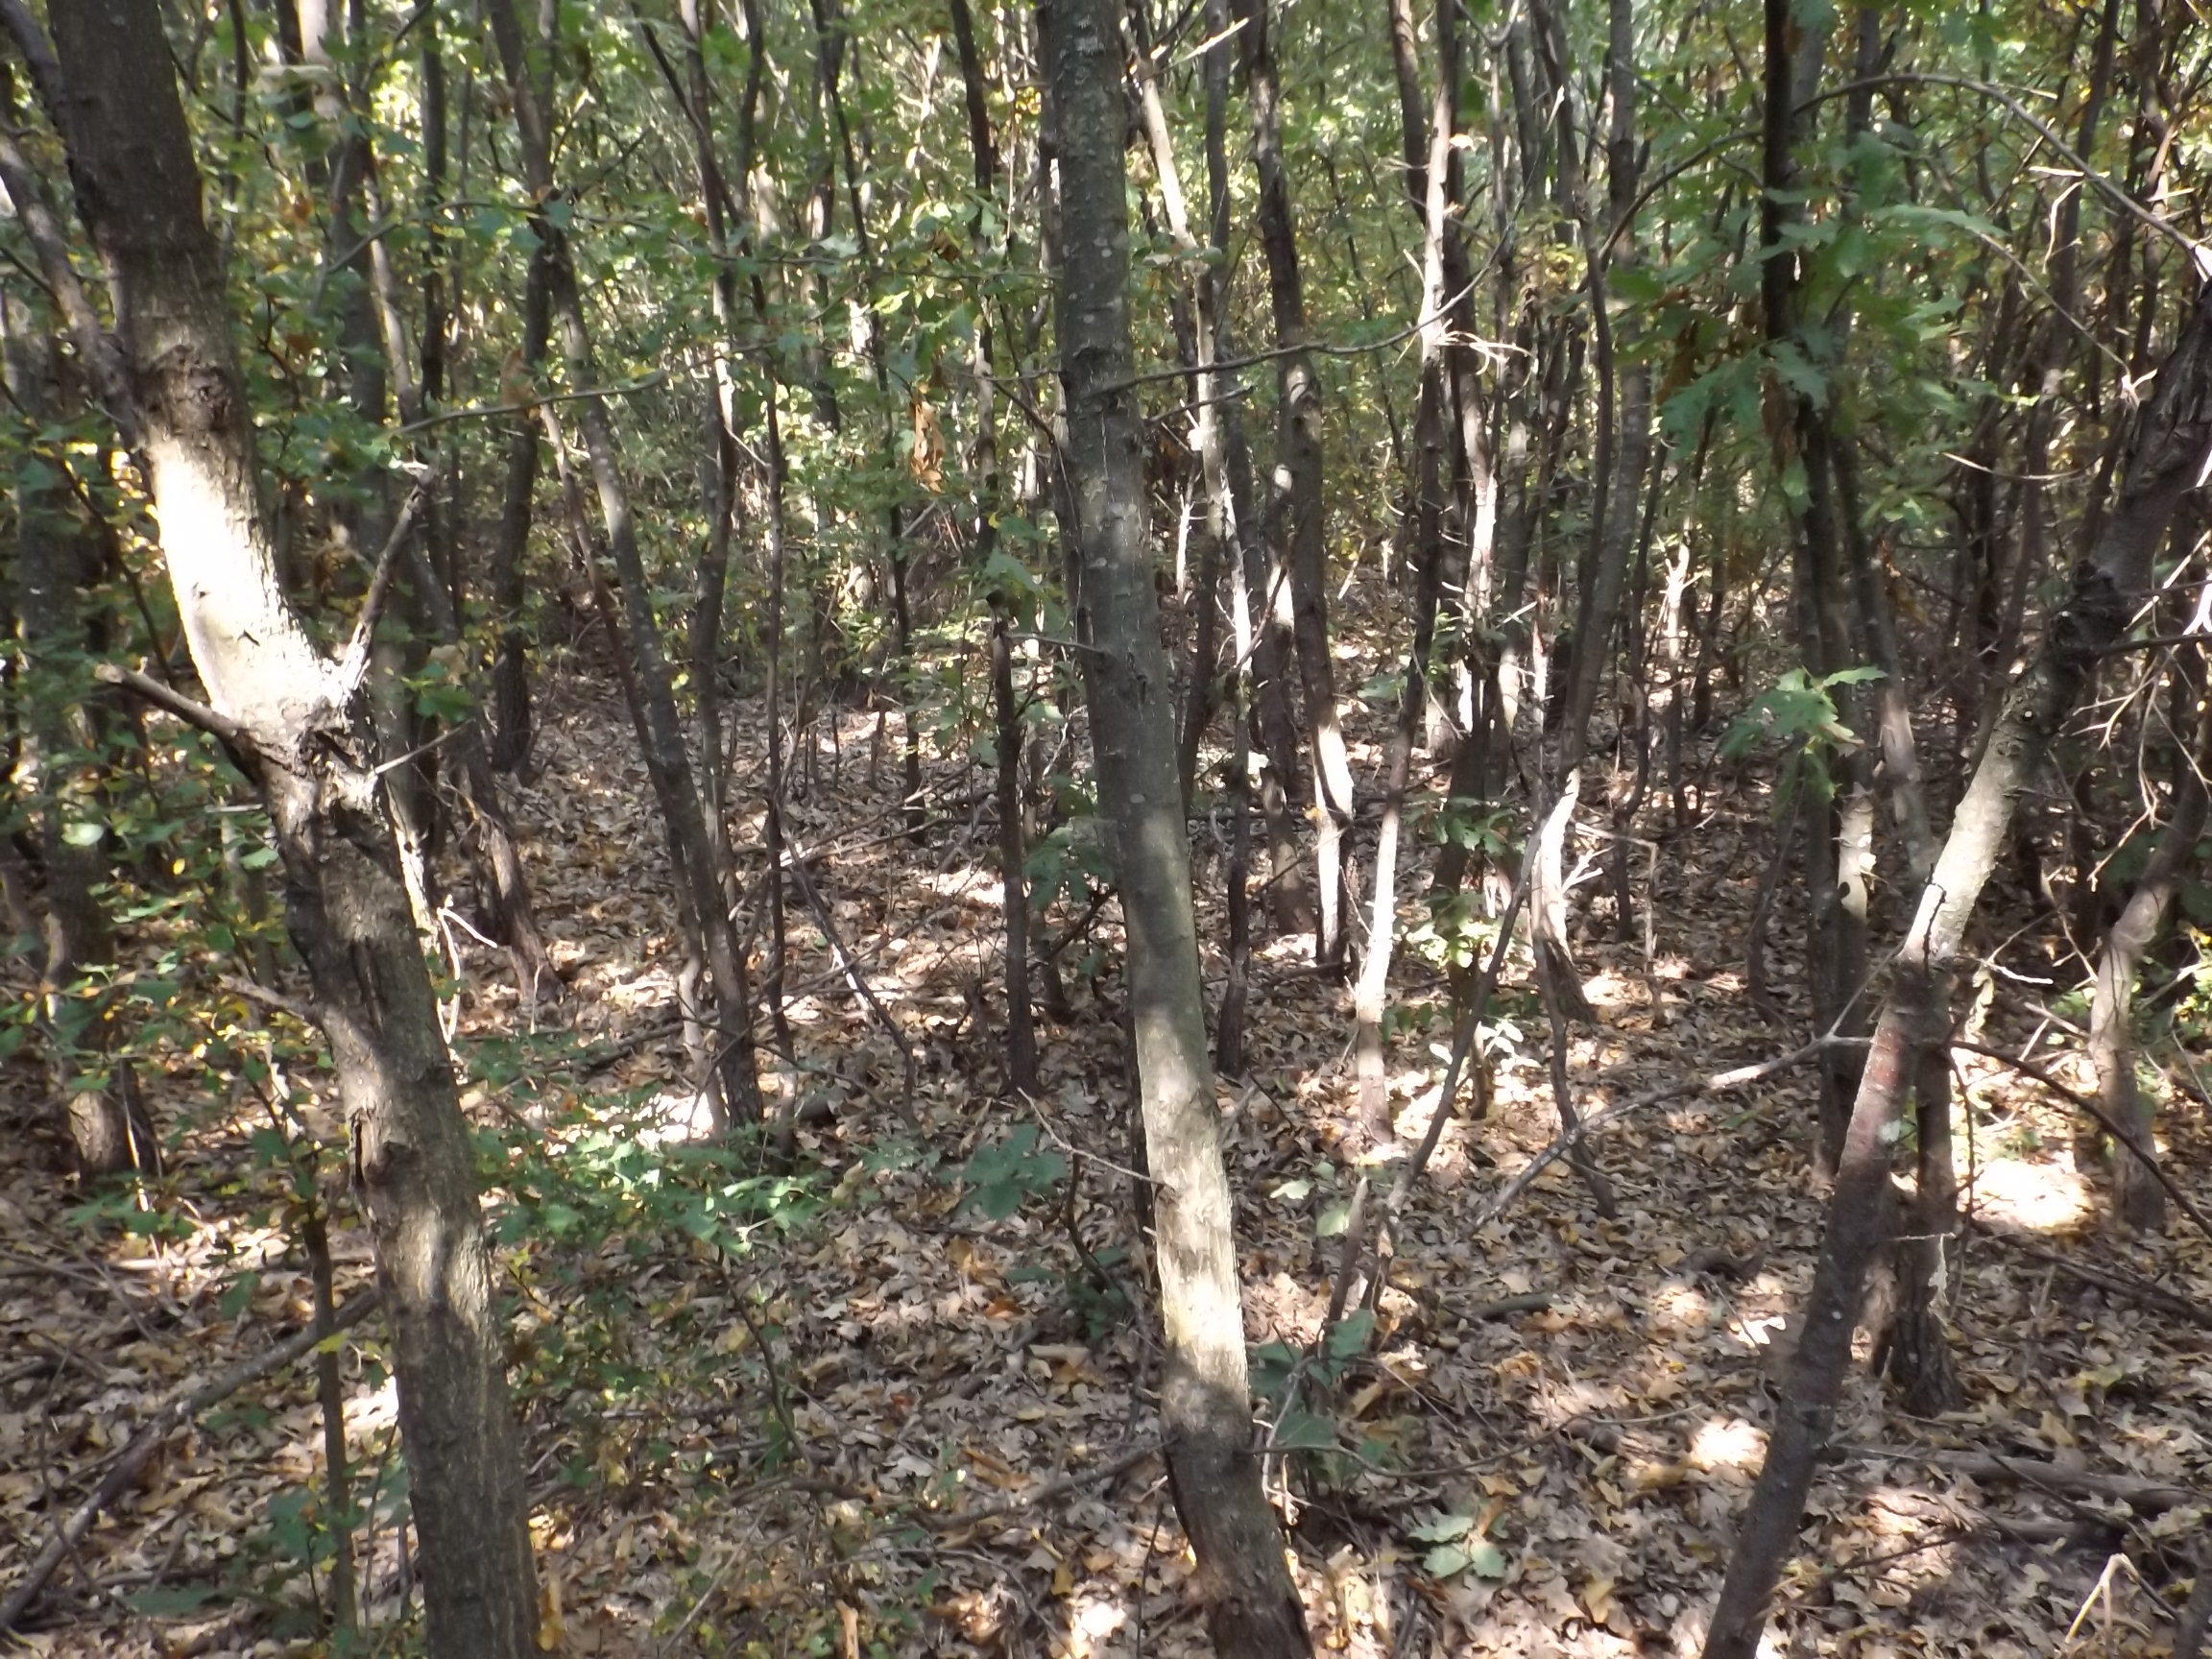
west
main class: Woodland
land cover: Broadleaved woodland
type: mesophytic deciduous forest
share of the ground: > 75 %
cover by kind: broadleaved forest trees 95 %, herbaceous plants 5 %
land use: Forestry
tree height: > 5 m
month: July
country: BG
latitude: 43.4790
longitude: 27.3739
